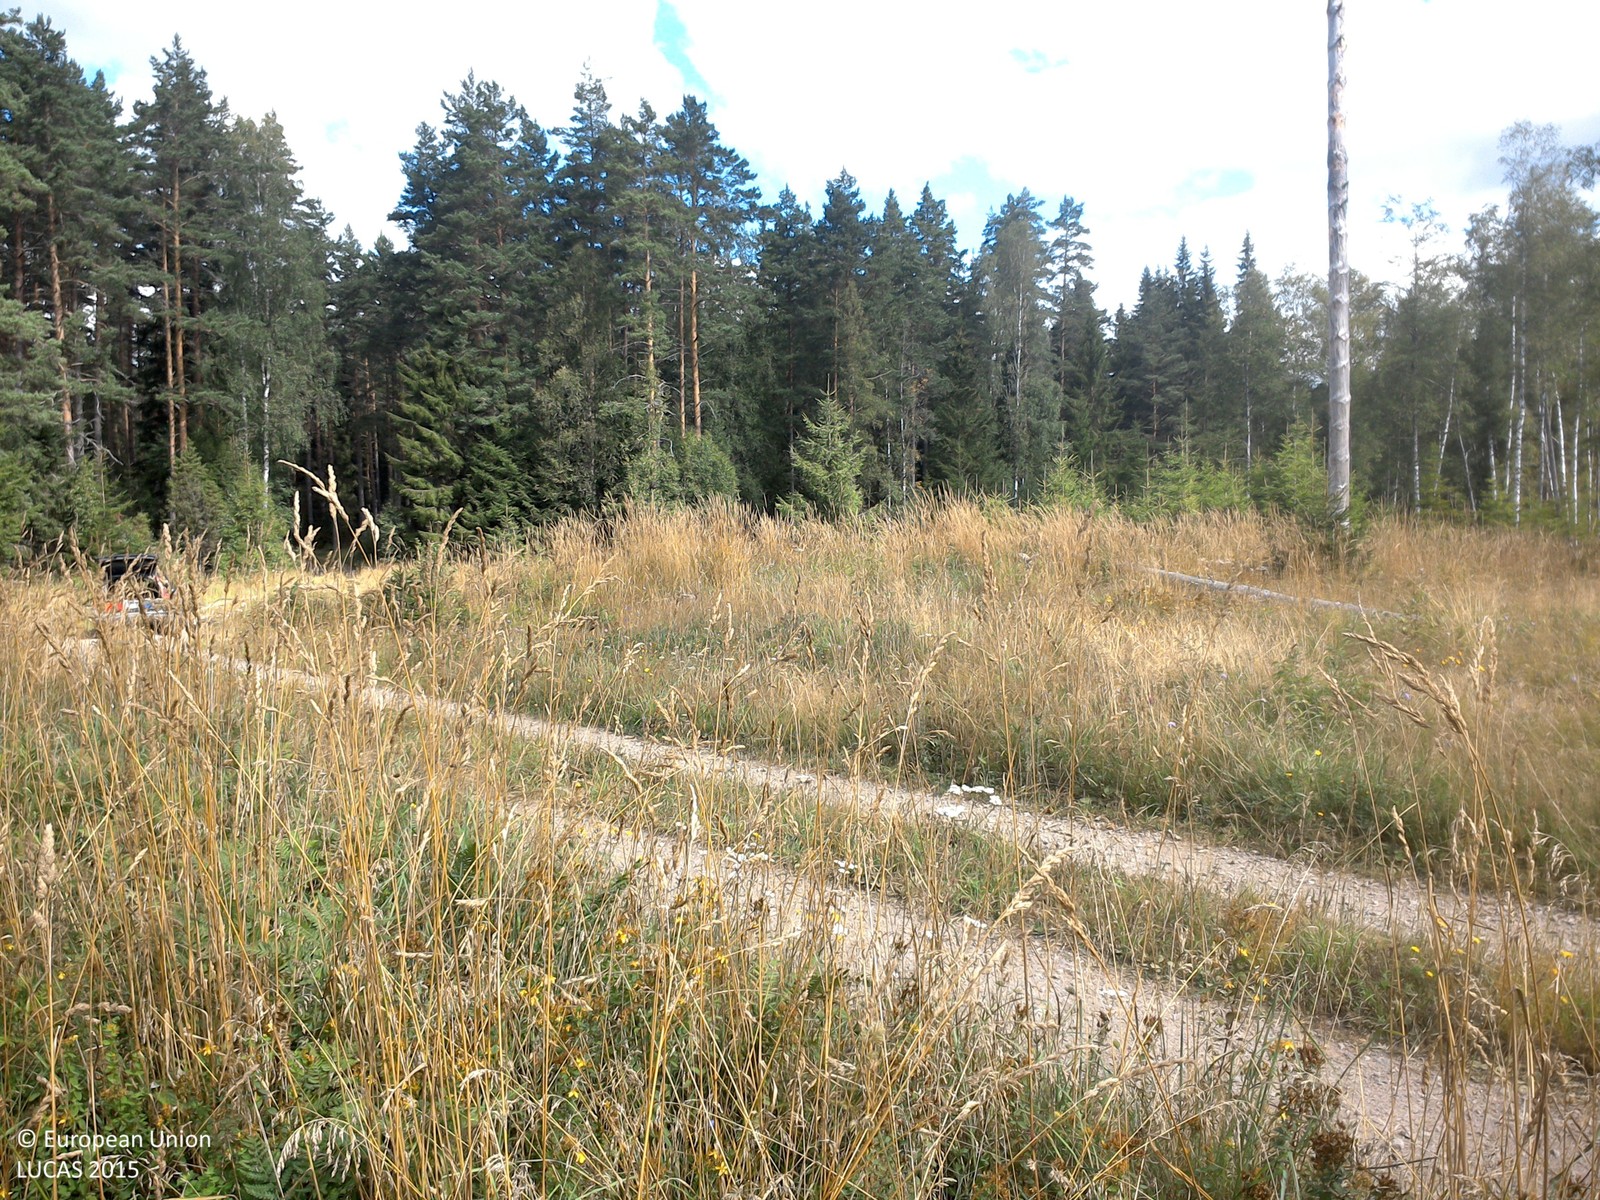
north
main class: Grassland
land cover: Grassland without tree/shrub cover
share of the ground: > 75 %
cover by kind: herbaceous plants 100 %
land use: Semi-natural and natural areas not in use
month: August
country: SE
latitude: 58.0762
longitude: 15.3700
